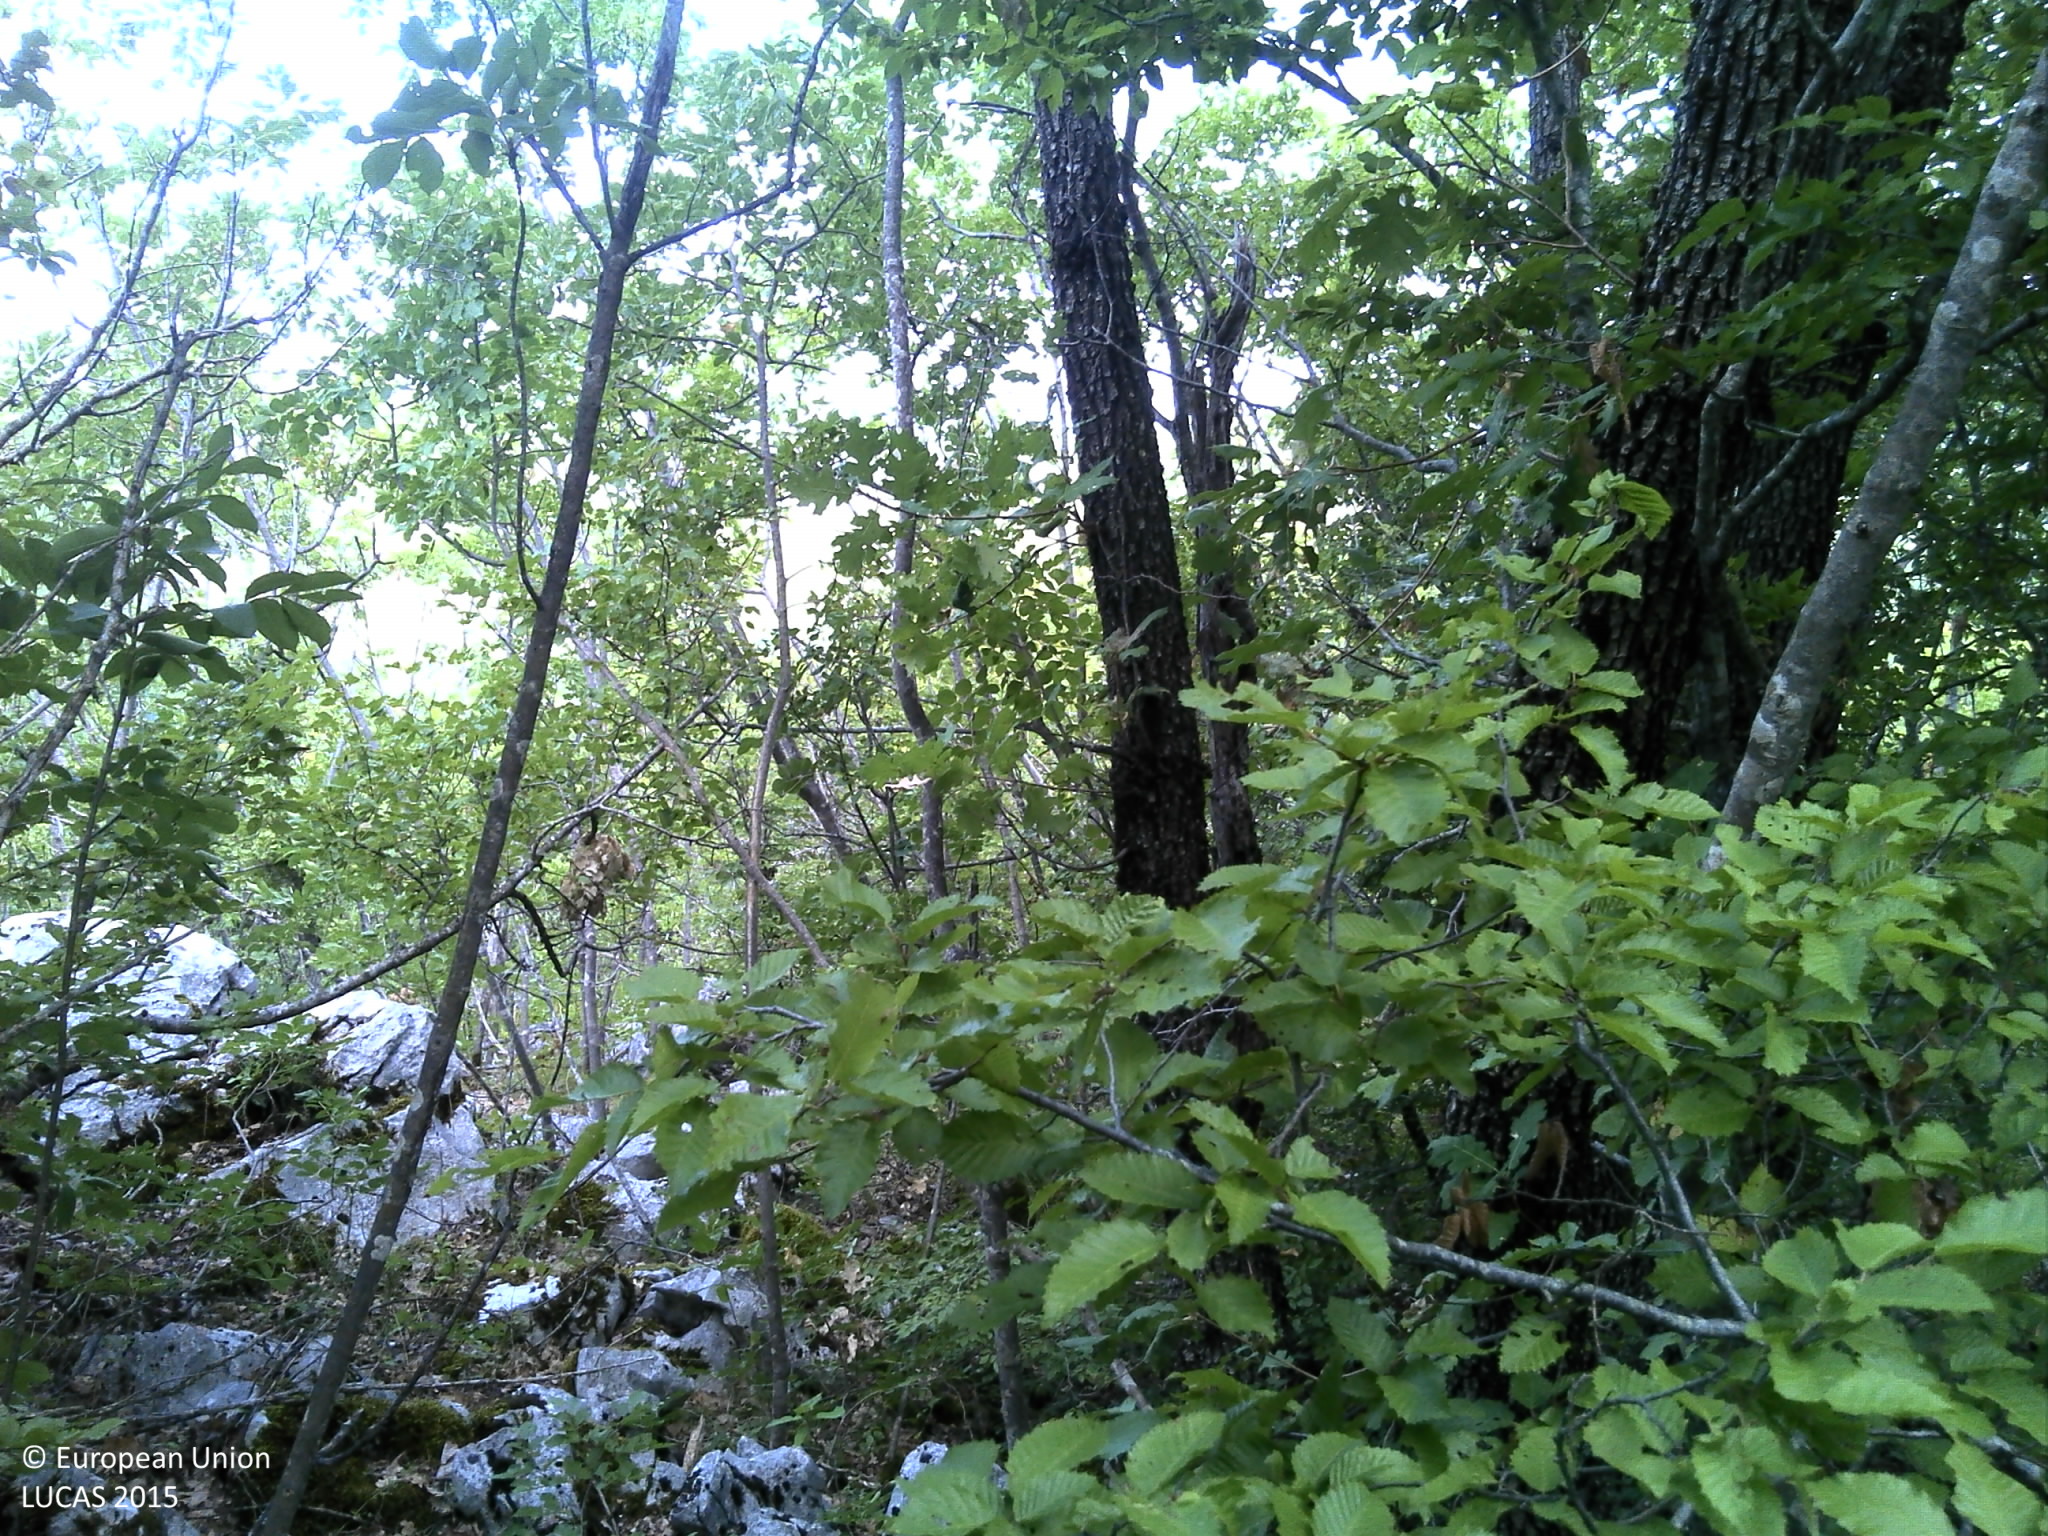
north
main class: Woodland
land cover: Broadleaved woodland
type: thermophilous deciduous forest
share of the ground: > 75 %
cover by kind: broadleaved forest trees 45 %, shrubs 30 %, herbaceous plants 10 %, consolidated bare surface 10 %, unconsolidated bare surface 5 %
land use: Semi-natural and natural areas not in use
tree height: > 5 m
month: August
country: HR
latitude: 43.3178
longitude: 17.2541
